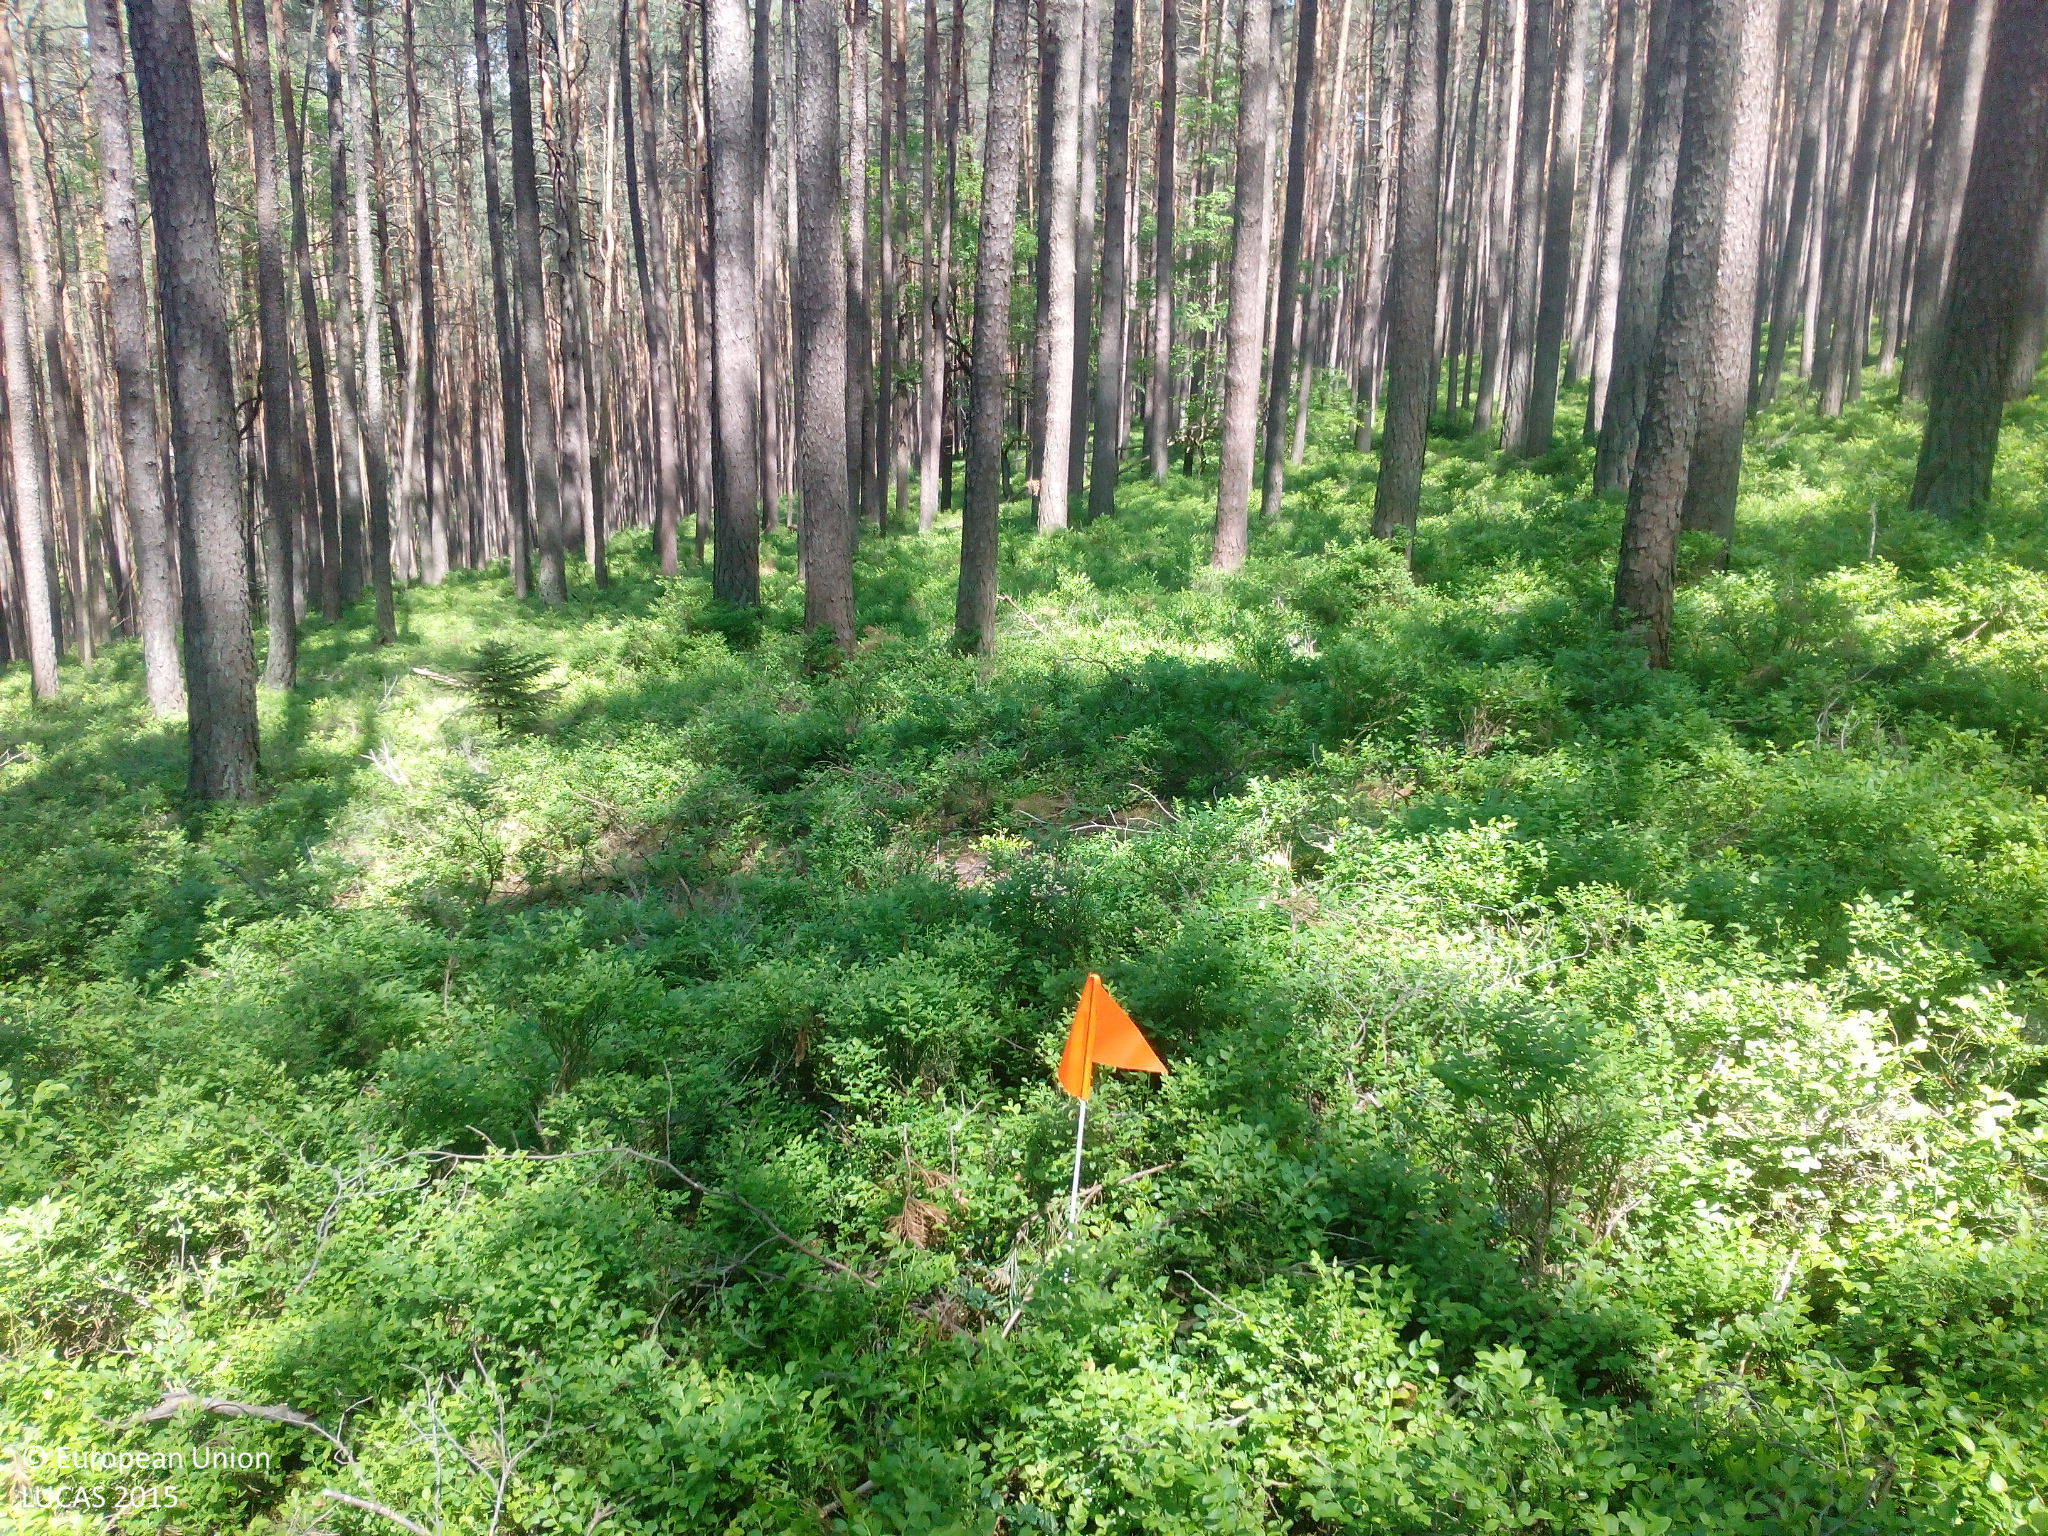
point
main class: Woodland
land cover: Pine dominated coniferous woodland
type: hemiboreal forest and nemoral coniferous forest and mixed broadleaved-coniferous forest
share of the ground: > 75 %
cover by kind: coniferous forest trees 85 %, herbaceous plants 15 %
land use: Forestry
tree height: > 5 m
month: May
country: DE
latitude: 49.1915
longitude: 10.8916
